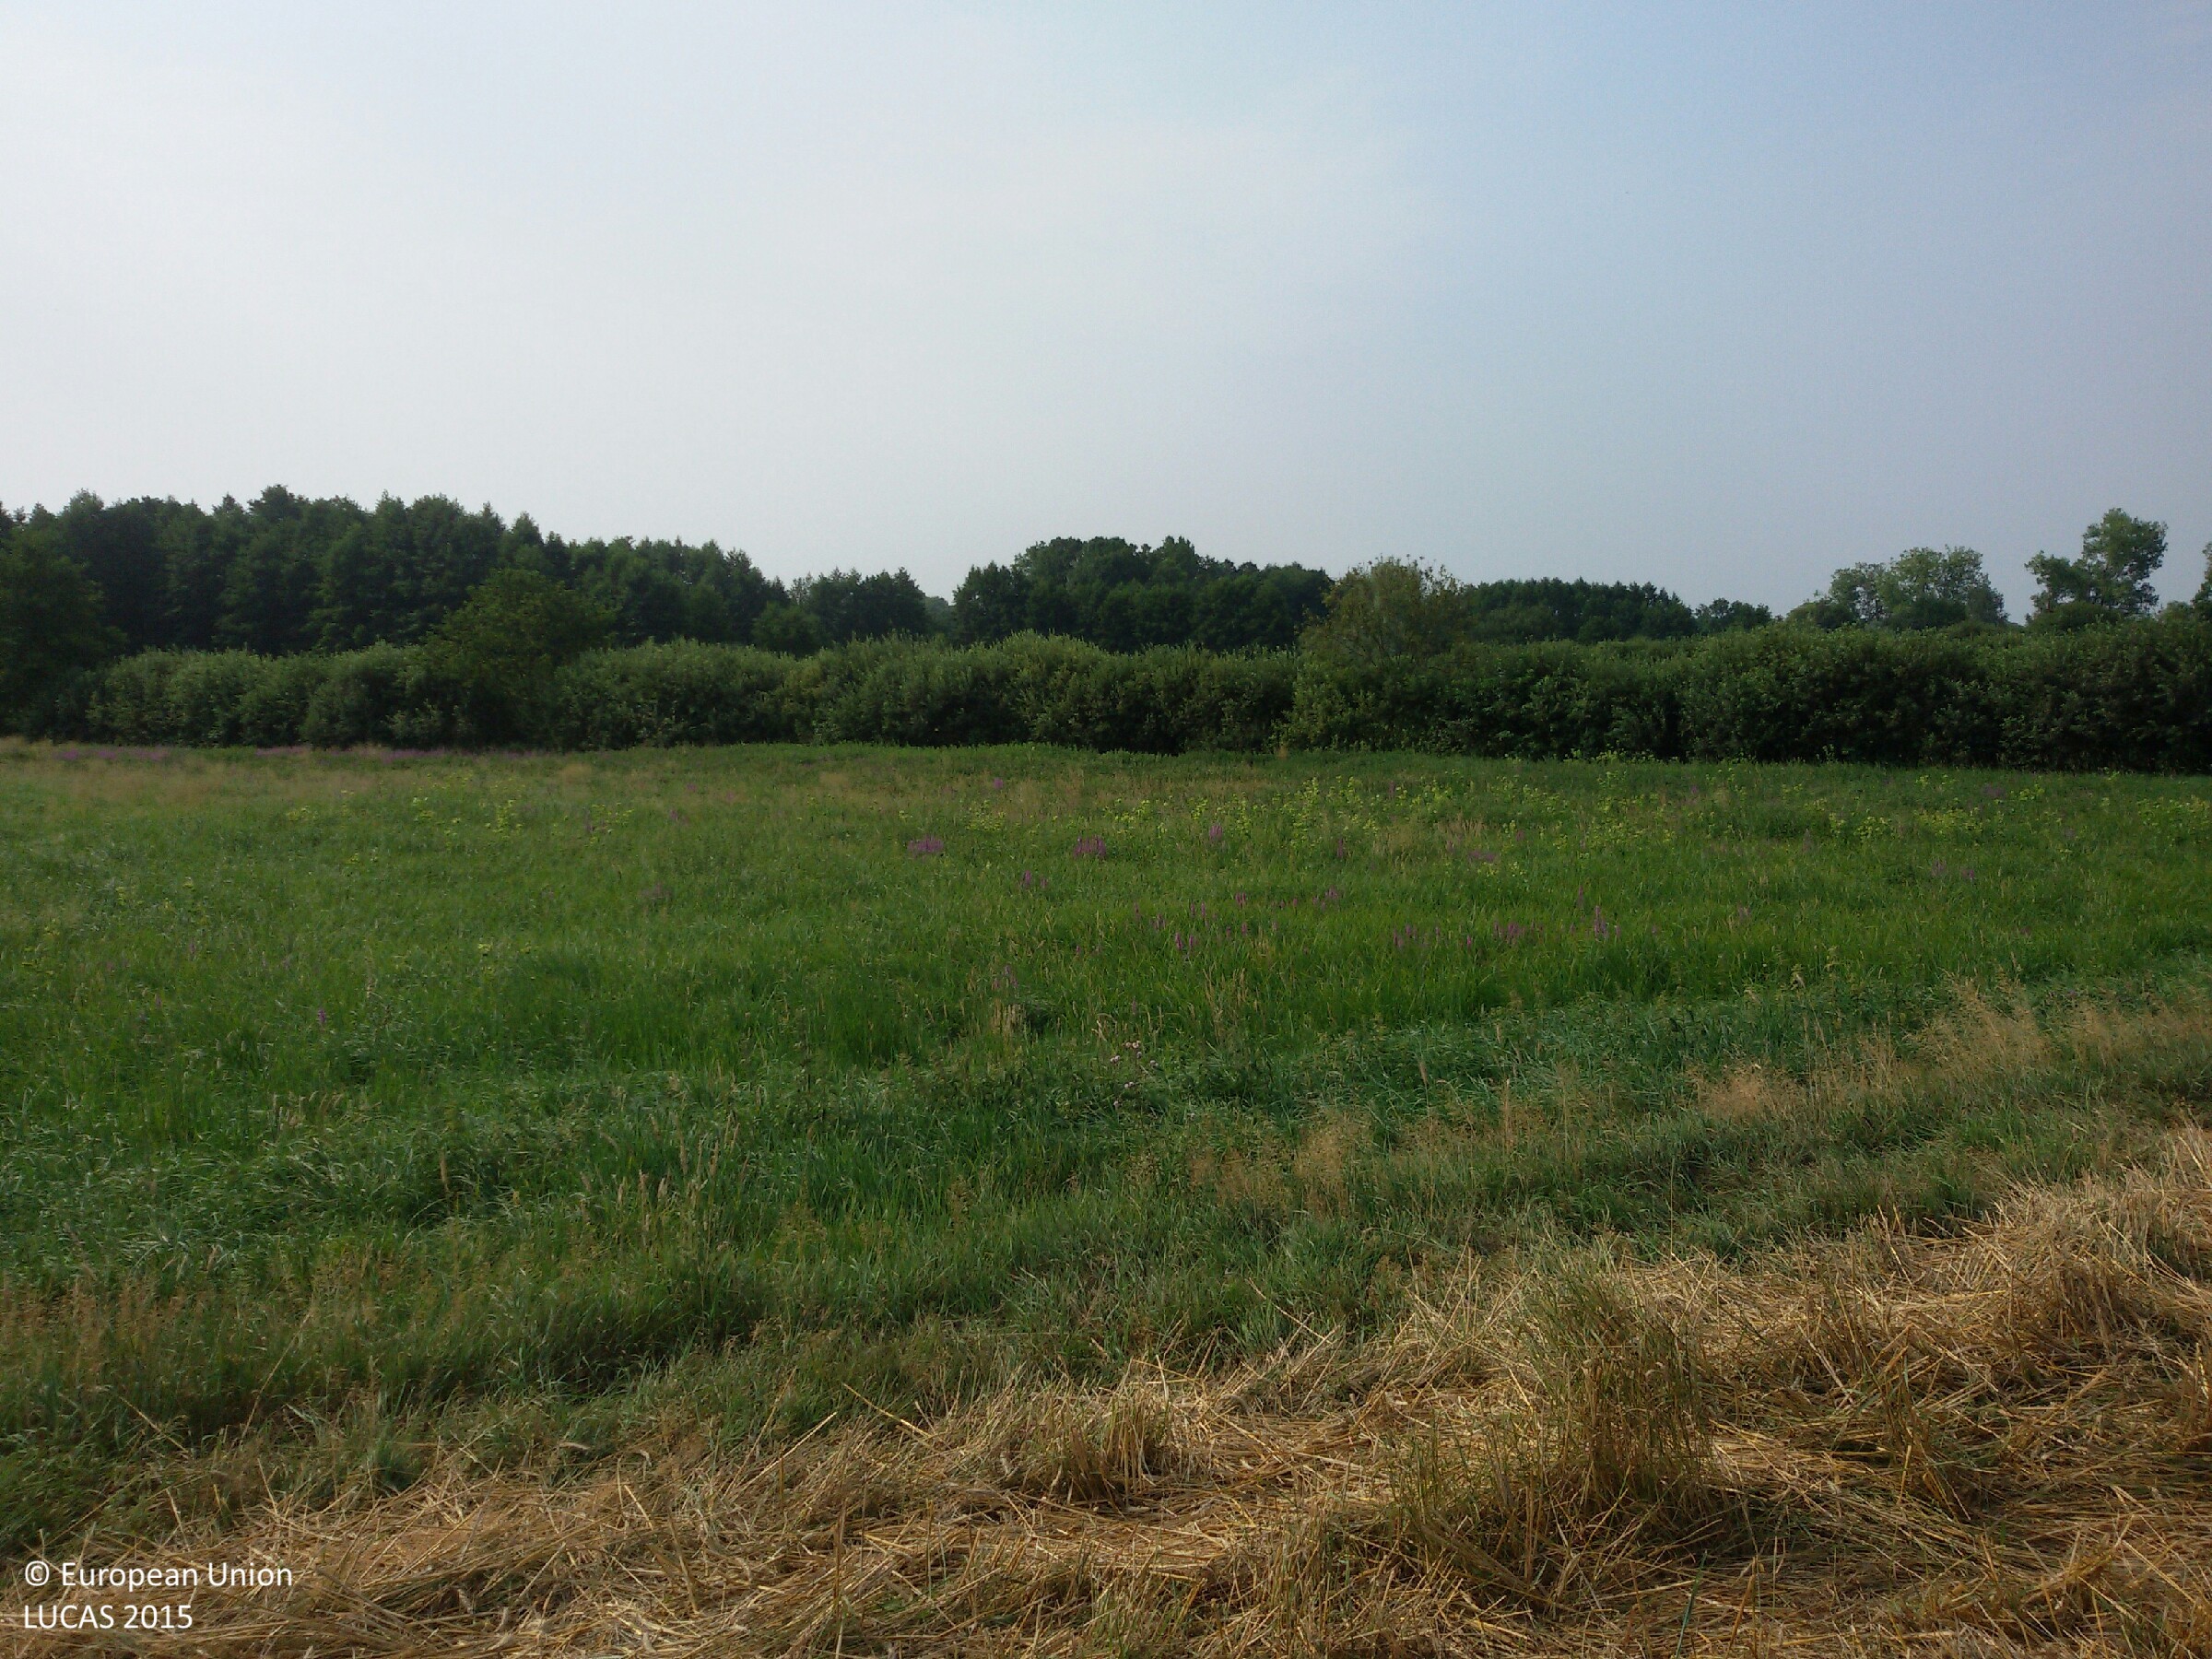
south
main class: Cropland
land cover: Rye
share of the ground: > 75 %
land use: Agriculture (excluding fallow land and kitchen gardens)
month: August
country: PL
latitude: 52.8323
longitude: 14.4989
